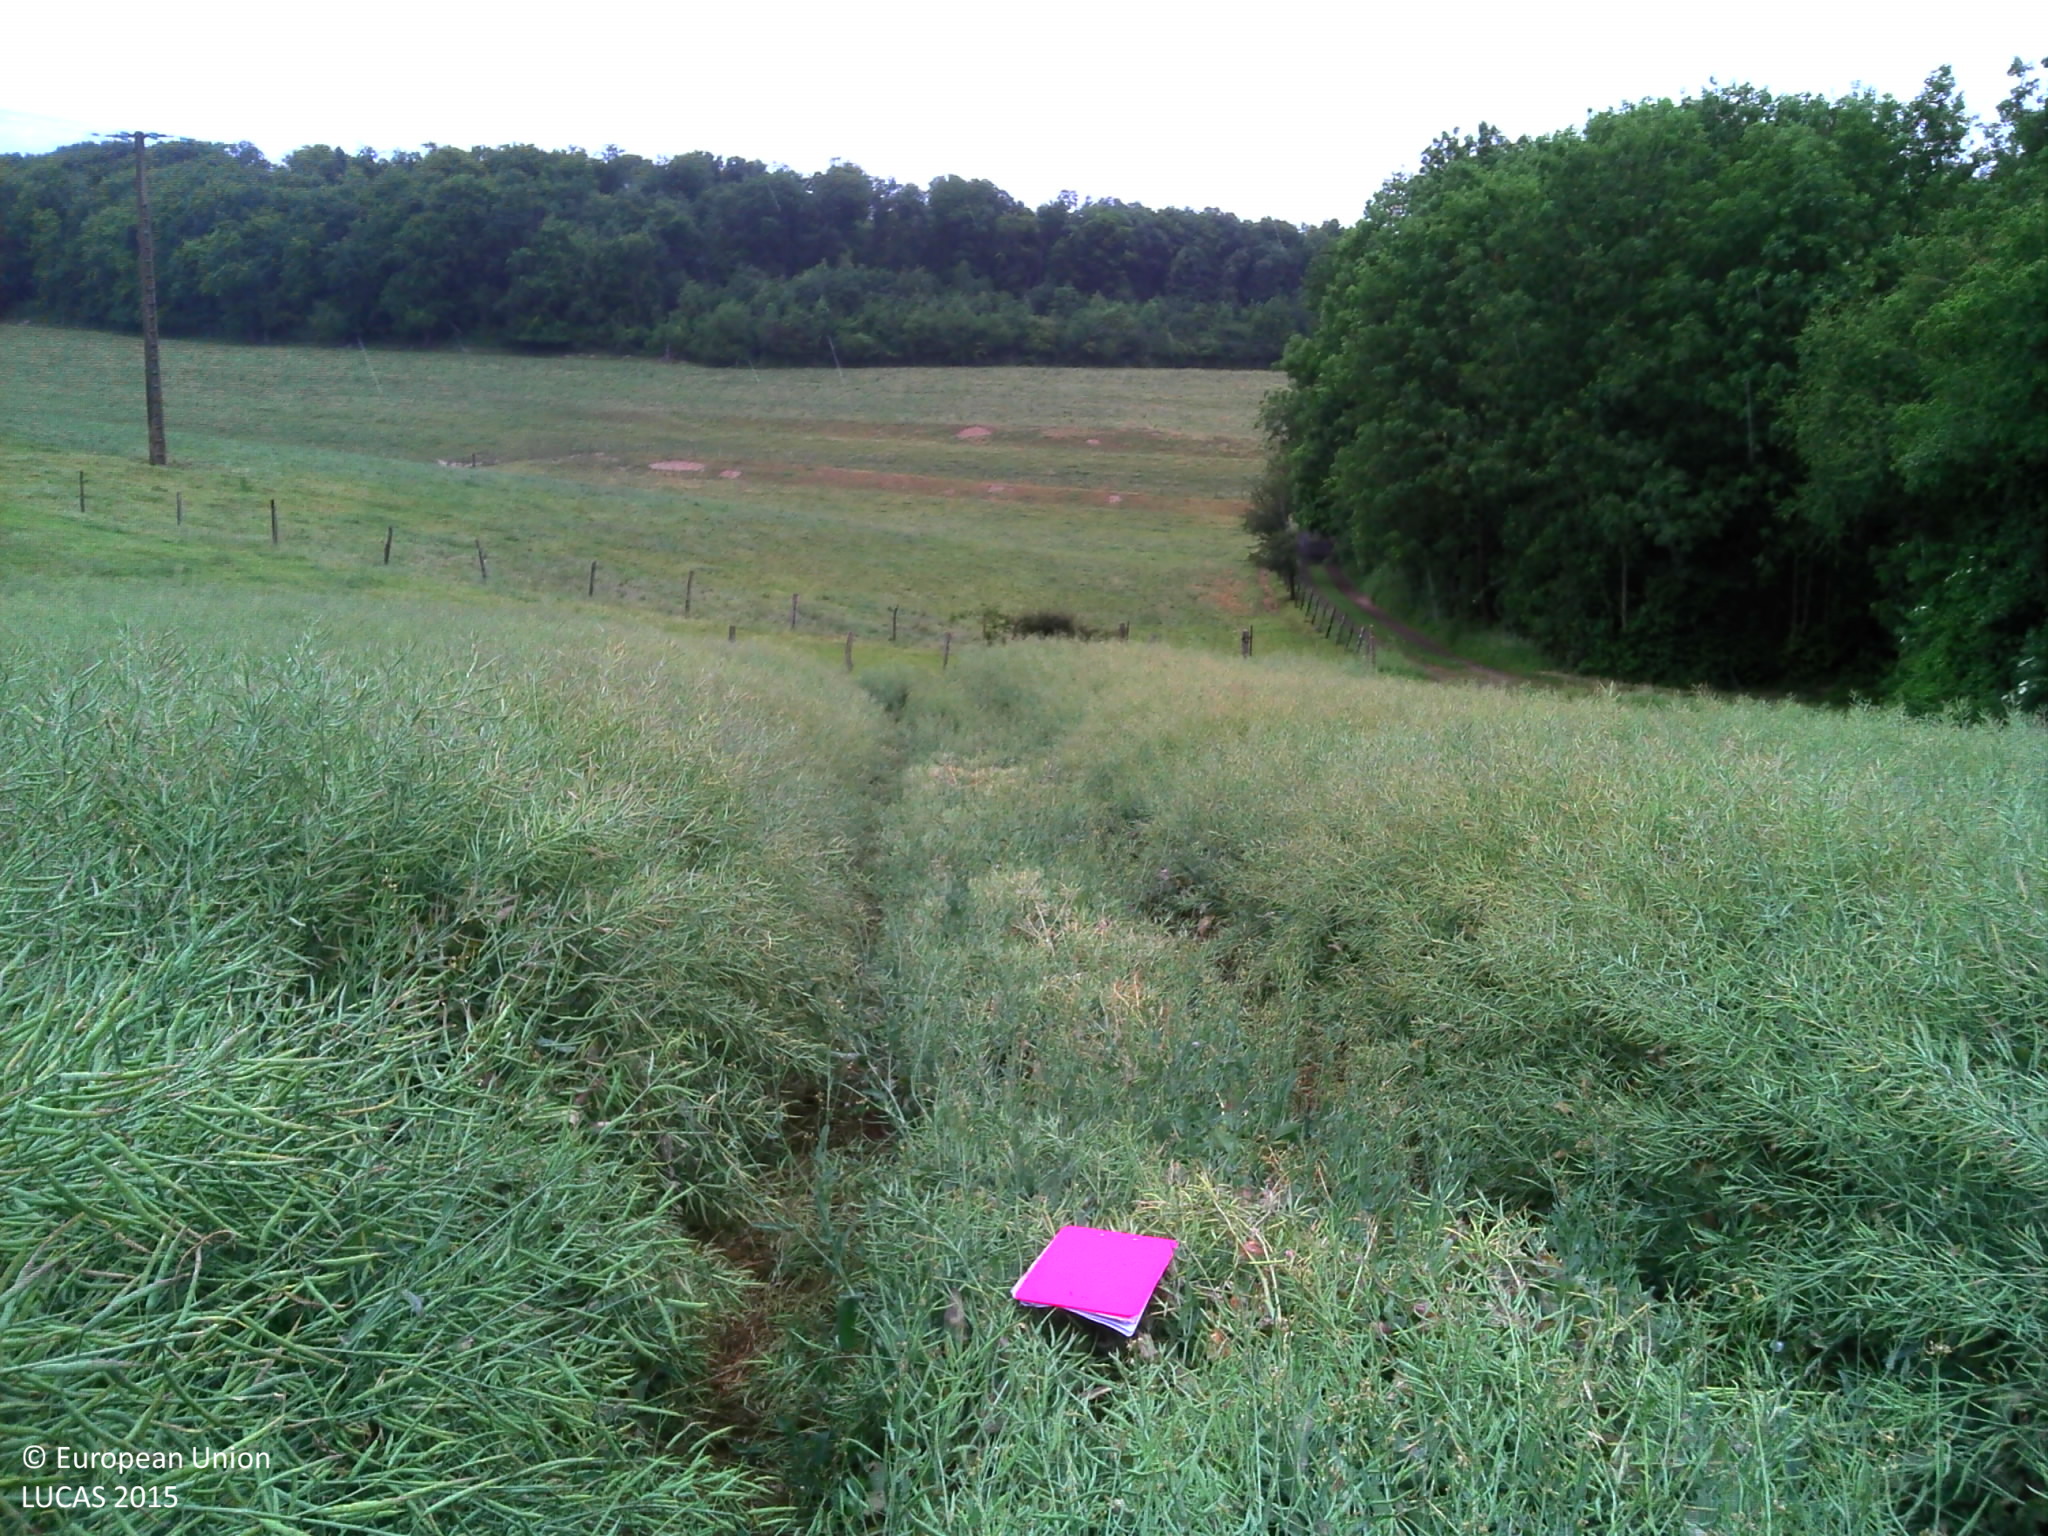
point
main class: Cropland
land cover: Rape and turnip rape
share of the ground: > 75 %
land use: Agriculture (excluding fallow land and kitchen gardens)
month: June
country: FR
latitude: 49.4795
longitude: 2.4101
